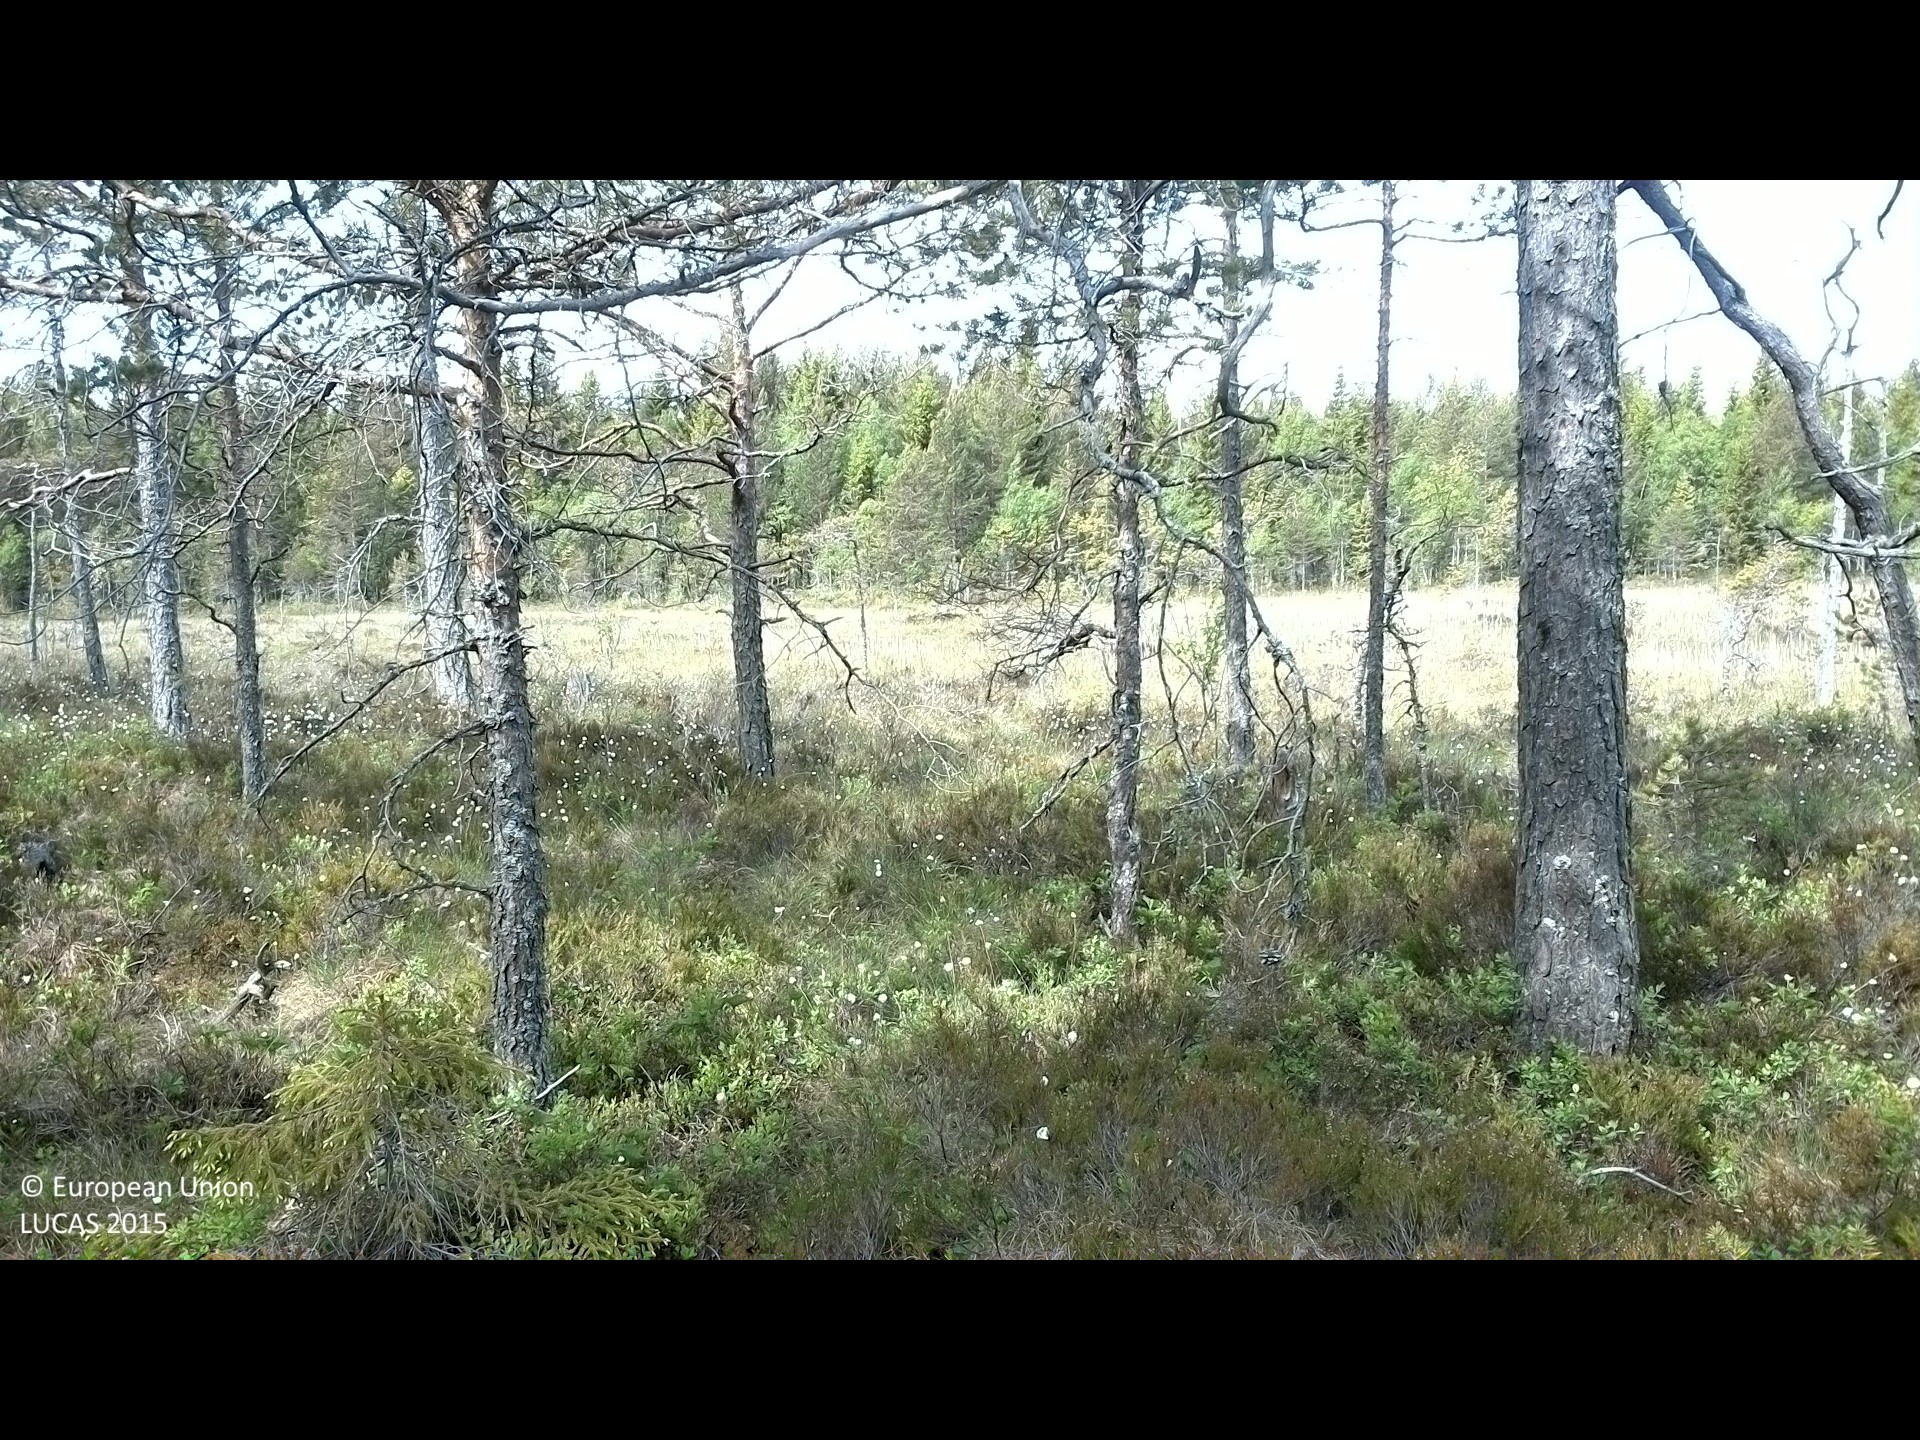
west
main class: Woodland
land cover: Pine dominated coniferous woodland
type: mire and swamp forests
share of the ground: 10 - 25 %
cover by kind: herbaceous plants 35 %, coniferous forest trees 25 %, shrubs 25 %, lichens and mosses 15 %
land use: Forestry
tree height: > 5 m
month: June
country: SE
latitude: 62.2399
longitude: 17.5837
